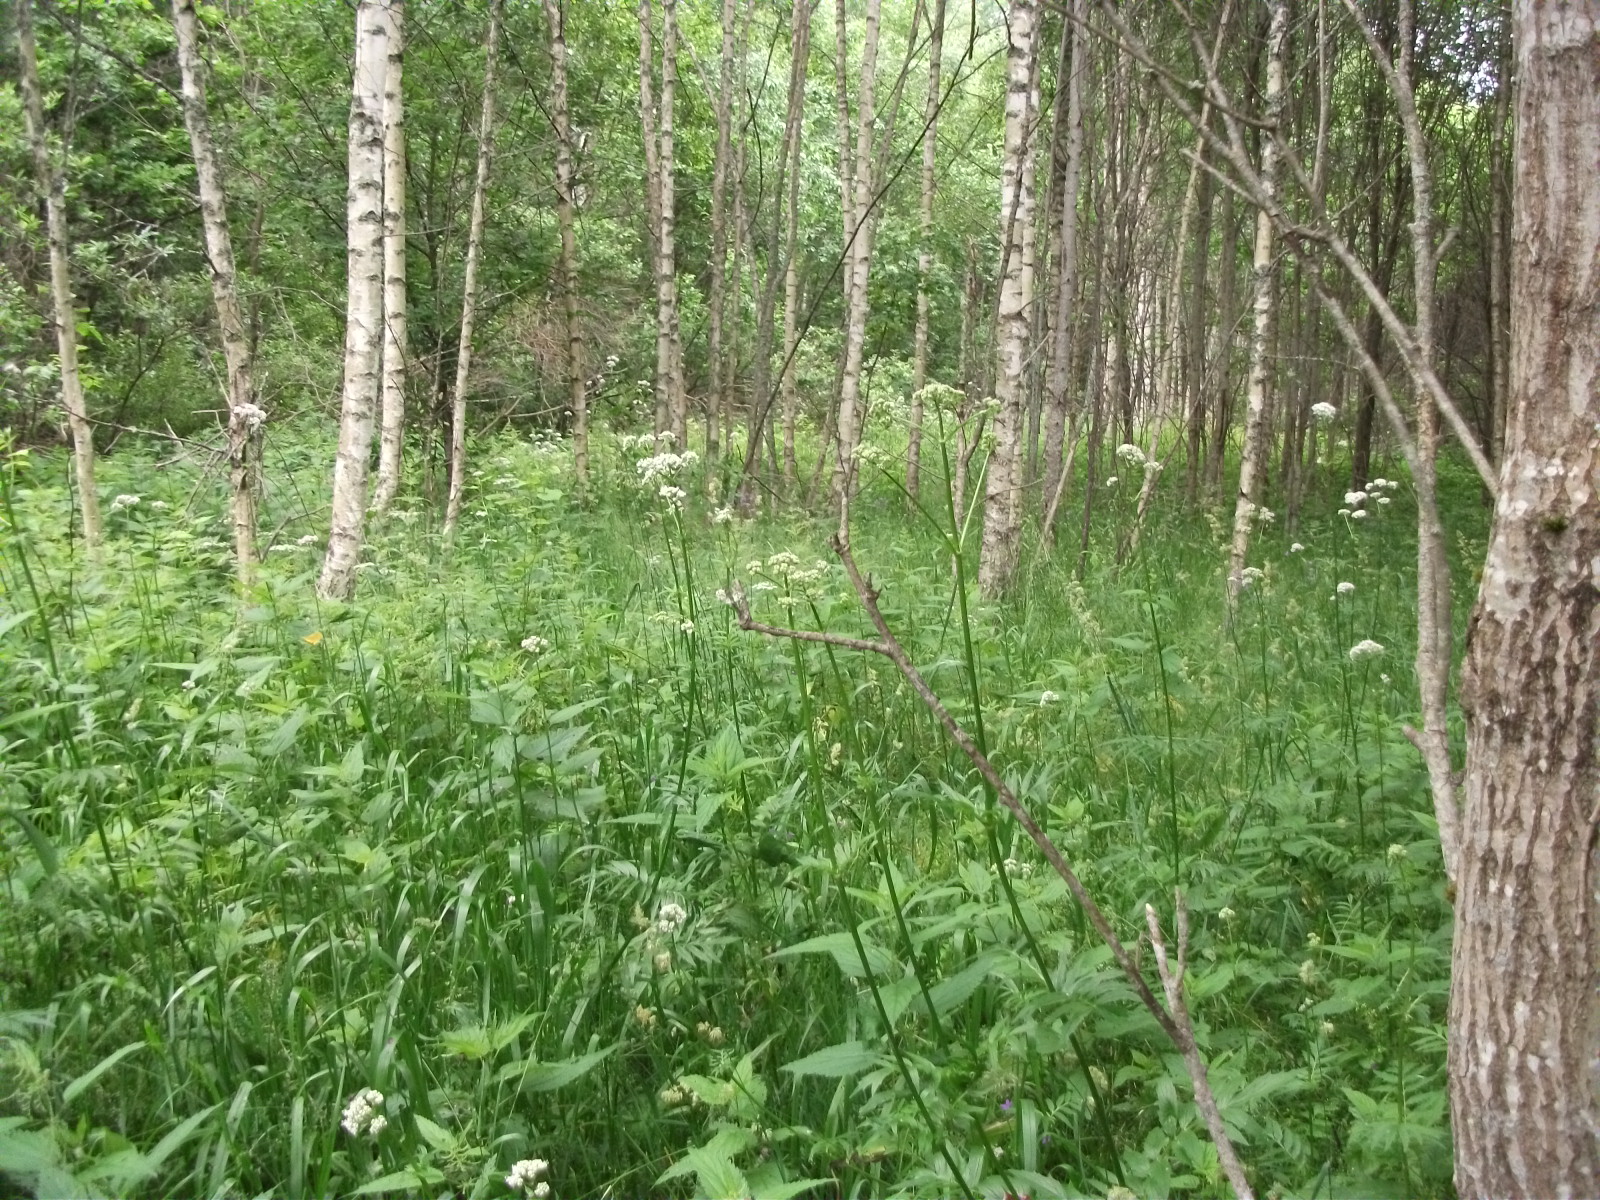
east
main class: Woodland
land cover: Broadleaved woodland
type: non-riverine alder, birch or aspen forest
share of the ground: > 75 %
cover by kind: broadleaved forest trees 90 %, herbaceous plants 10 %
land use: Semi-natural and natural areas not in use
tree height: > 5 m
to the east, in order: Broadleaved woodland; Ditches and canals; Broadleaved woodland; Ditches and canals; Grassland without tree/shrub cover; Common wheat
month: January
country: LV
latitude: 56.8799
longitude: 26.6082
